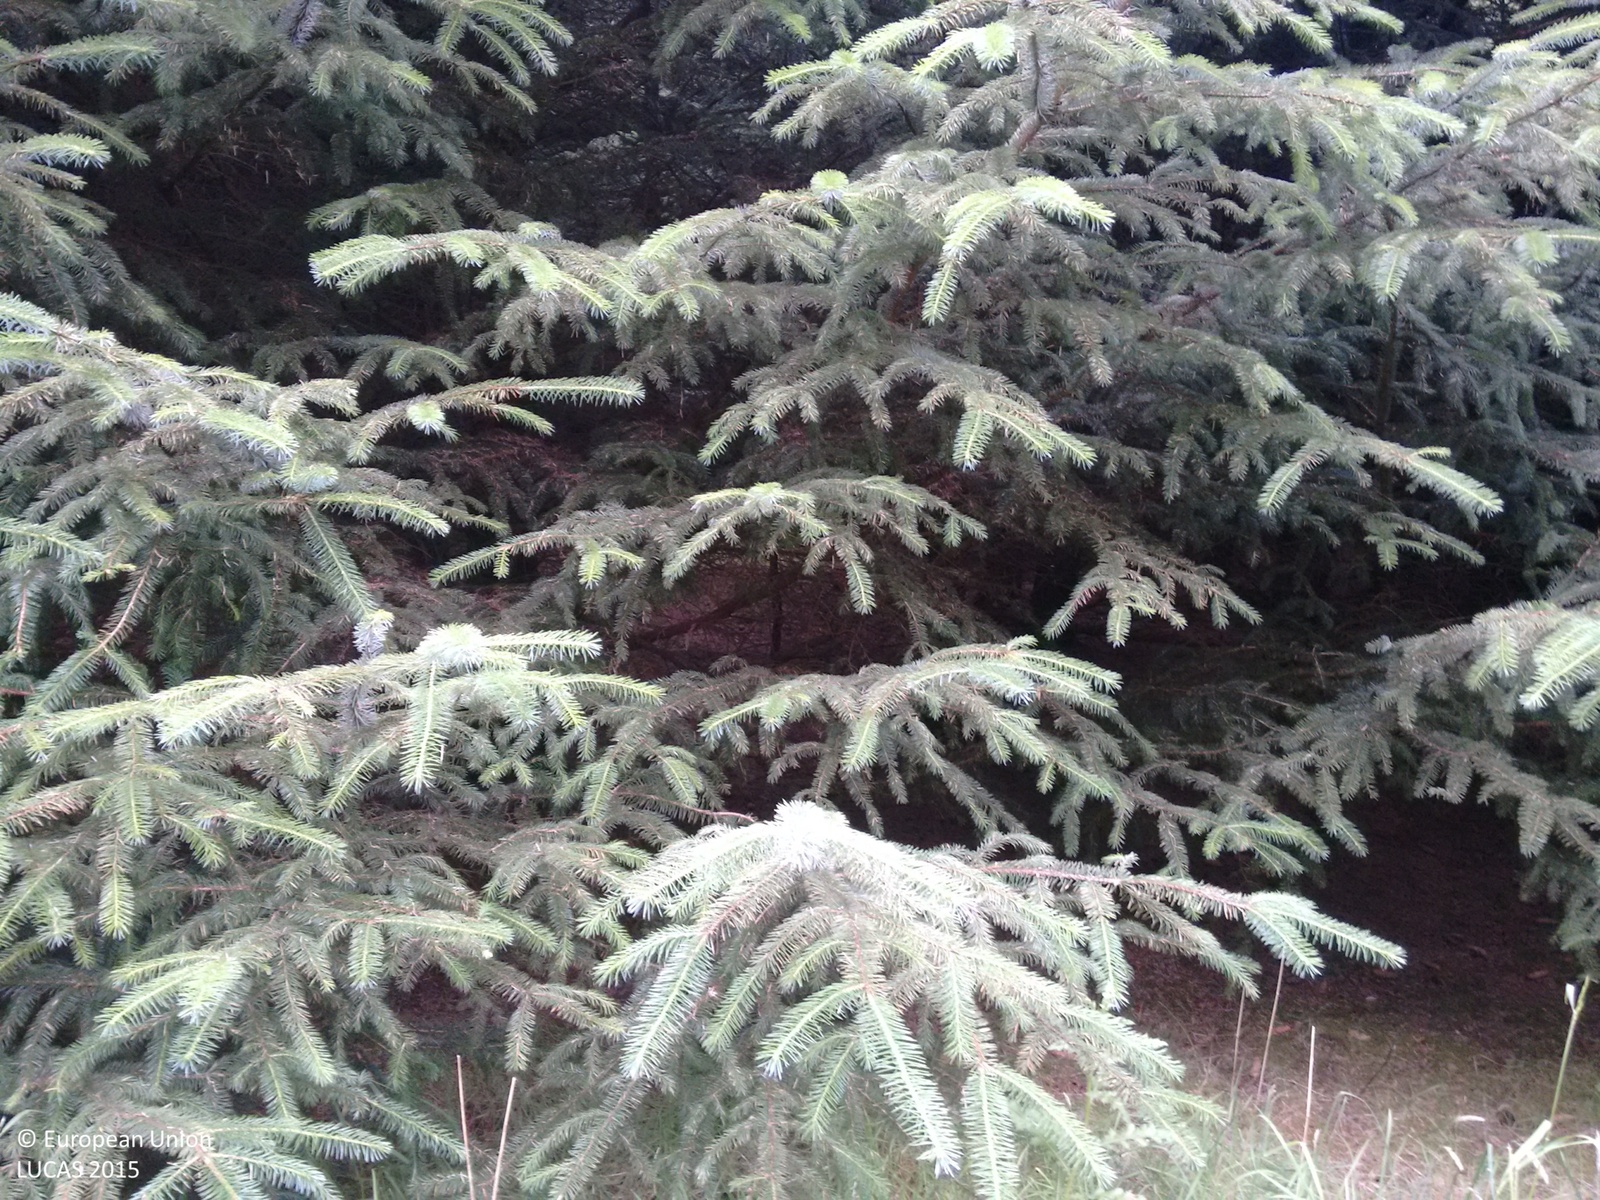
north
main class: Woodland
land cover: Spruce dominated coniferous woodland
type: exotic forest
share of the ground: > 75 %
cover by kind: coniferous forest trees 95 %, herbaceous plants 5 %
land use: Forestry
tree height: > 5 m
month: July
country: GB
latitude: 57.3923
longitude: -2.3465
